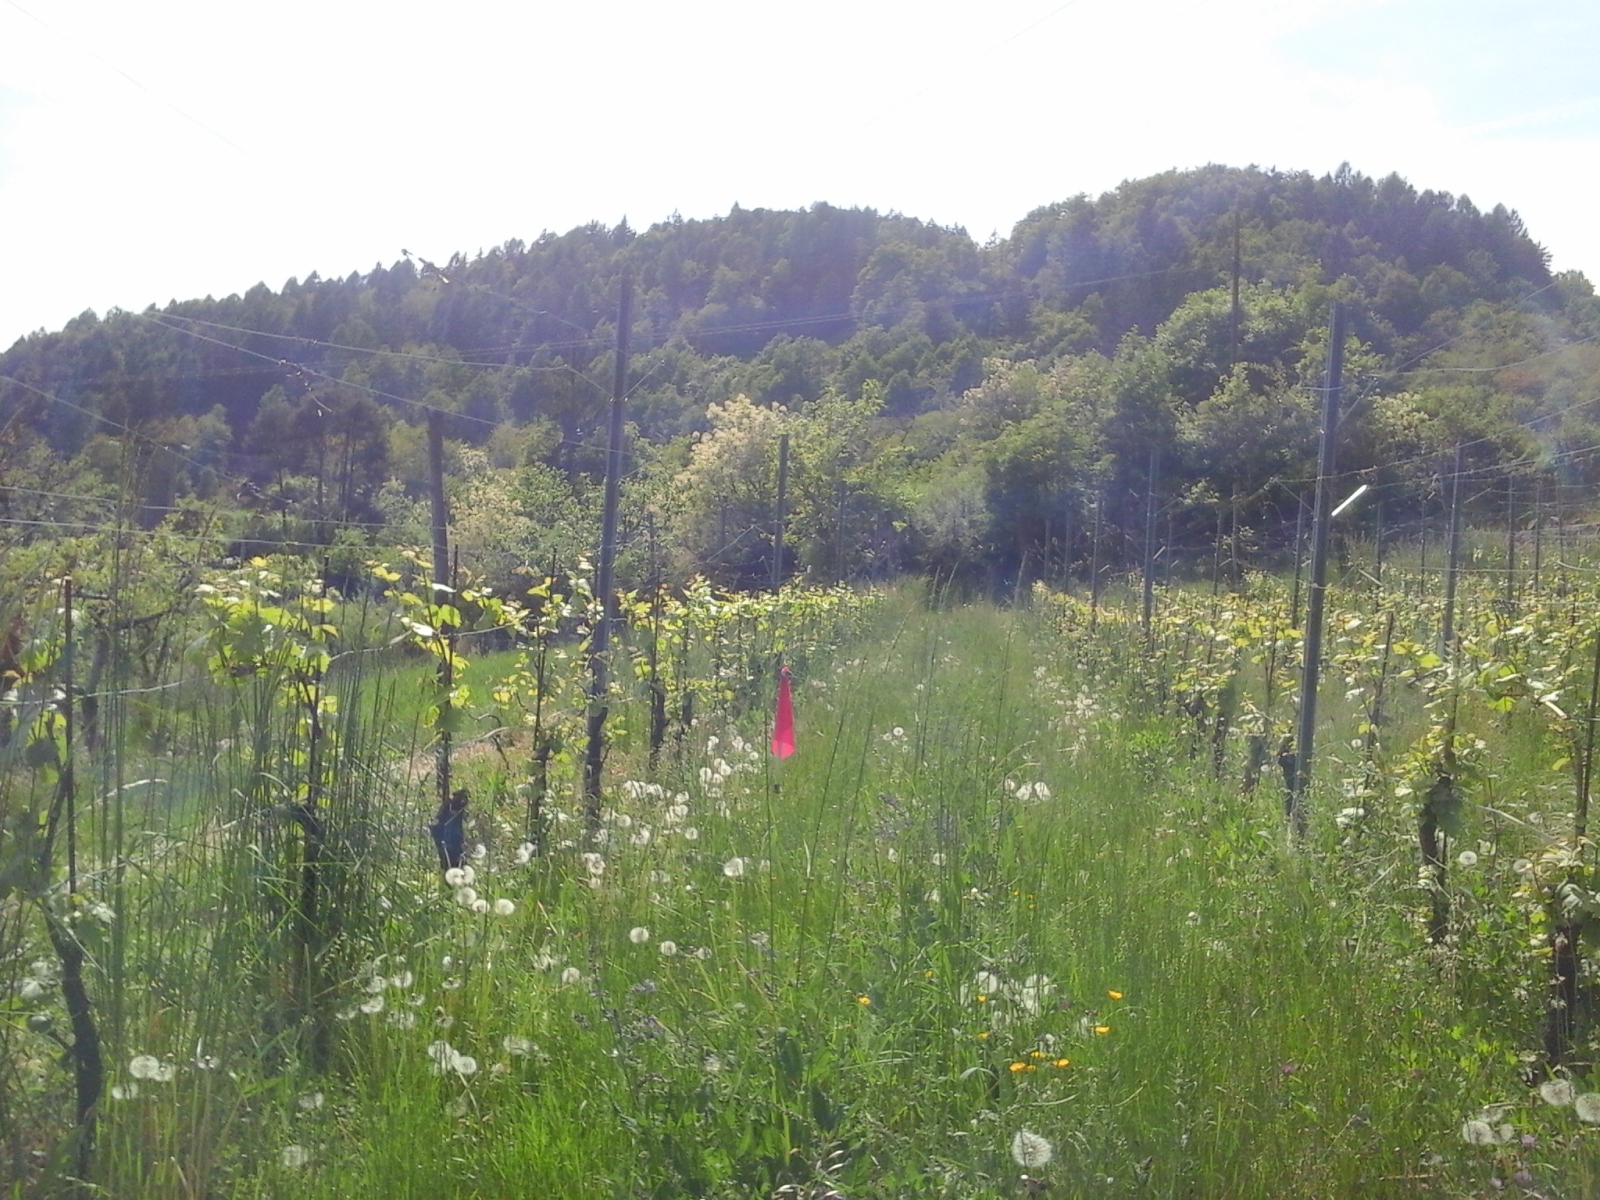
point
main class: Cropland
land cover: Vineyards
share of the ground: < 10 %
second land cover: Grassland without tree/shrub cover
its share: > 75 %
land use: Agriculture (excluding fallow land and kitchen gardens)
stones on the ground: < 10 %
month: May
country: IT
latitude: 46.1105
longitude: 11.1757
